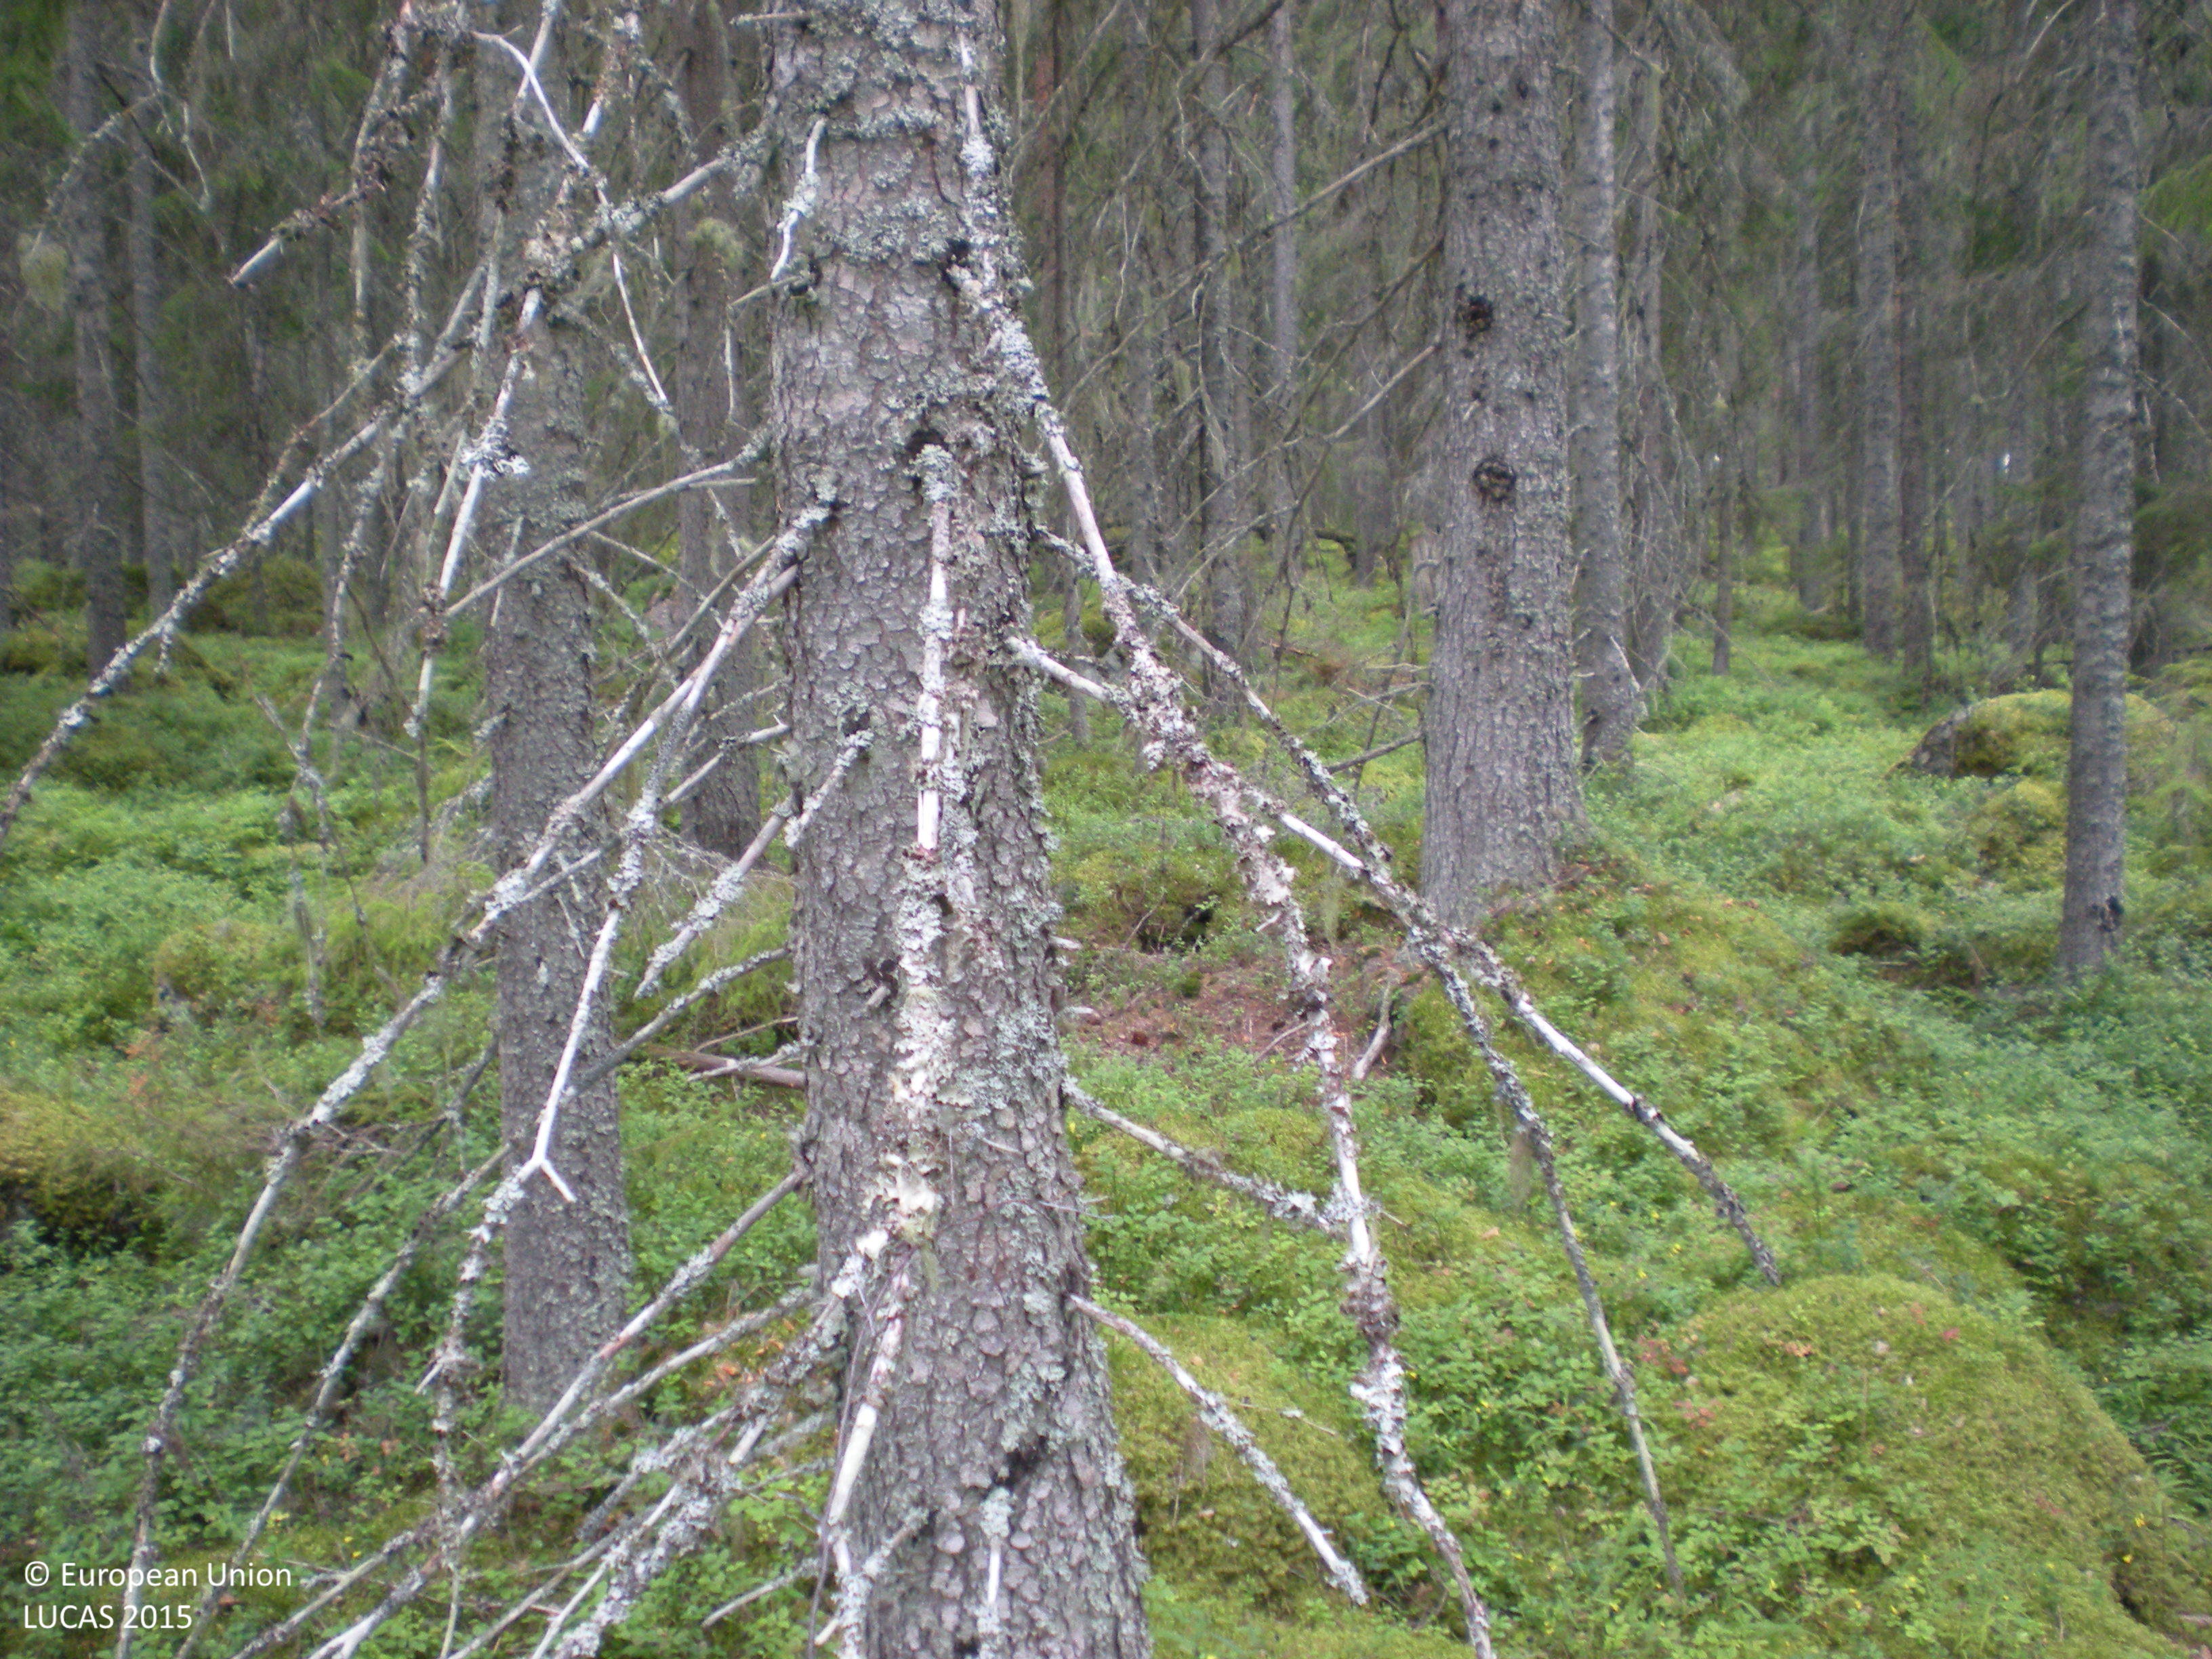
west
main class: Woodland
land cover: Other coniferous woodland
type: boreal forest
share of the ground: 50 - 75 %
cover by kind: coniferous forest trees 65 %, shrubs 15 %, lichens and mosses 10 %, herbaceous plants 5 %, consolidated bare surface 5 %
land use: Forestry
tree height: > 5 m
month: August
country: SE
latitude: 60.8477
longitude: 17.1838
